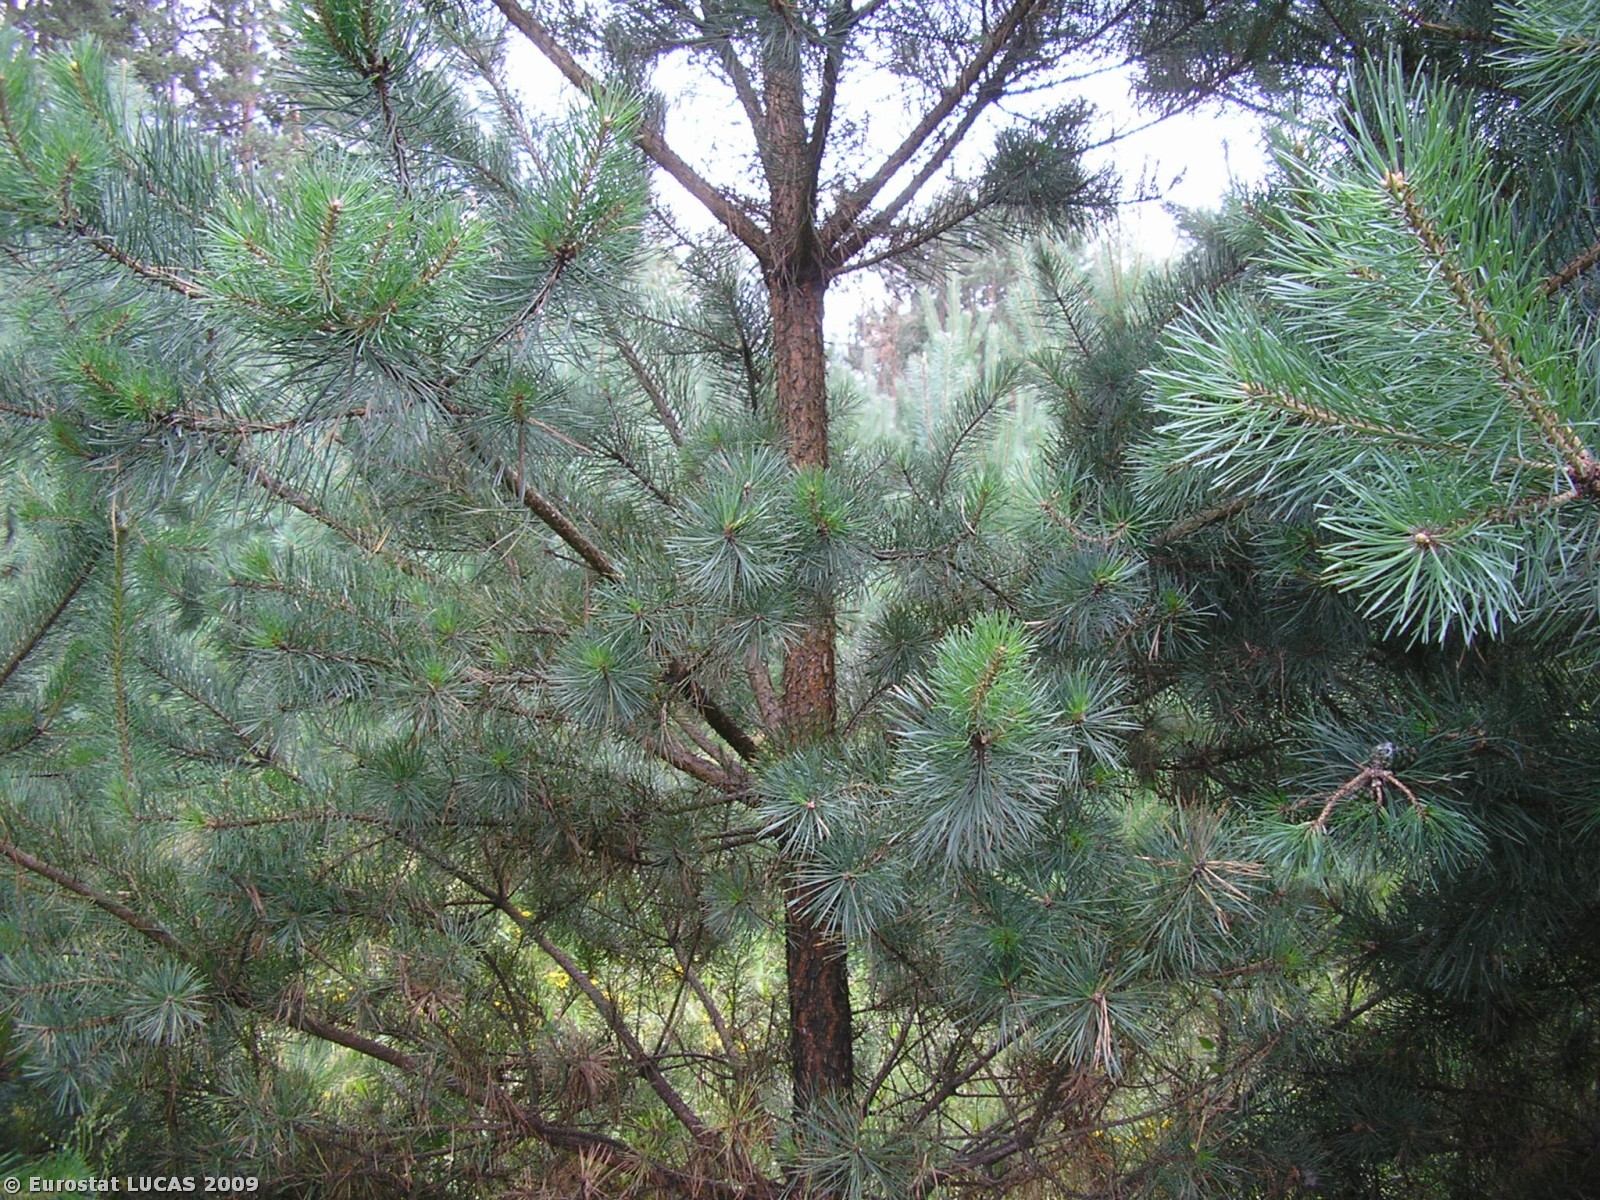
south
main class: Woodland
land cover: Coniferous woodland
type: hemiboreal forest and nemoral coniferous forest and mixed broadleaved-coniferous forest
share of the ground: > 75 %
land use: Forestry
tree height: > 5 m
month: July
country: PL
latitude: 51.4865
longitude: 21.5294
